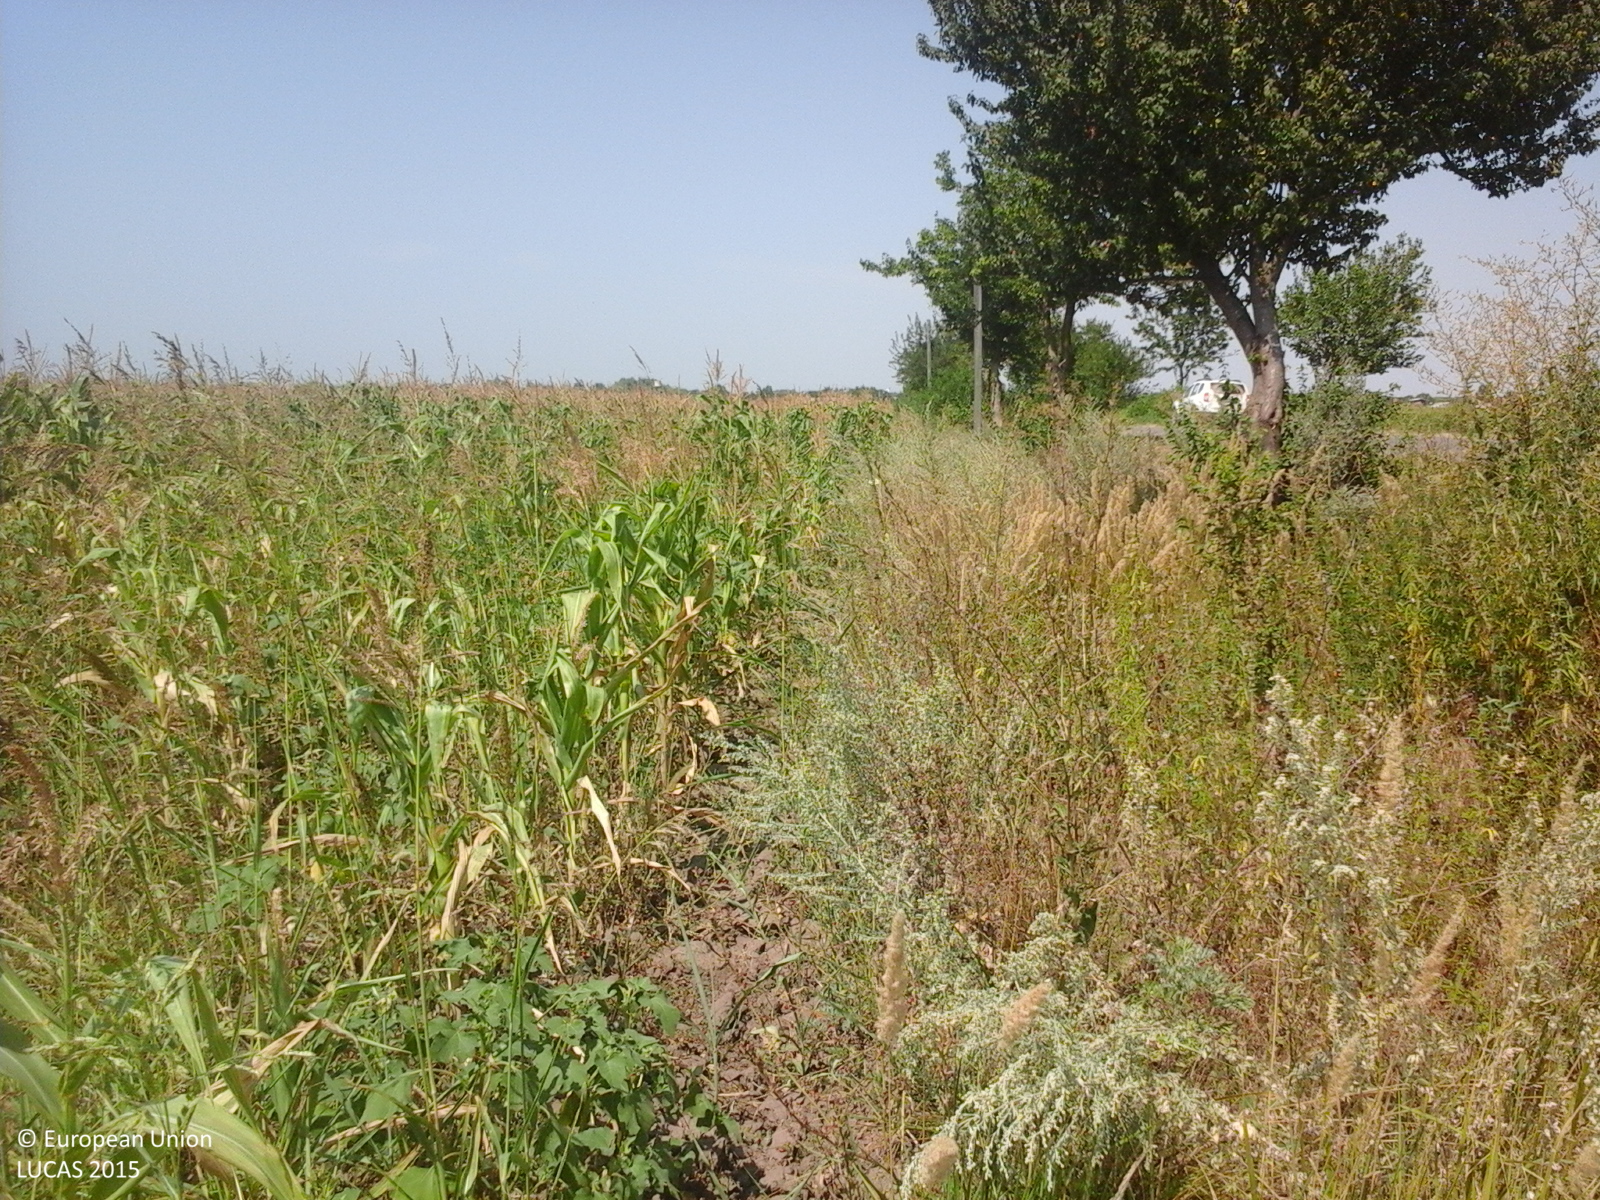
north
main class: Cropland
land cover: Maize
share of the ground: > 75 %
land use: Agriculture (excluding fallow land and kitchen gardens)
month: August
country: RO
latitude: 45.2992
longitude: 27.8234
